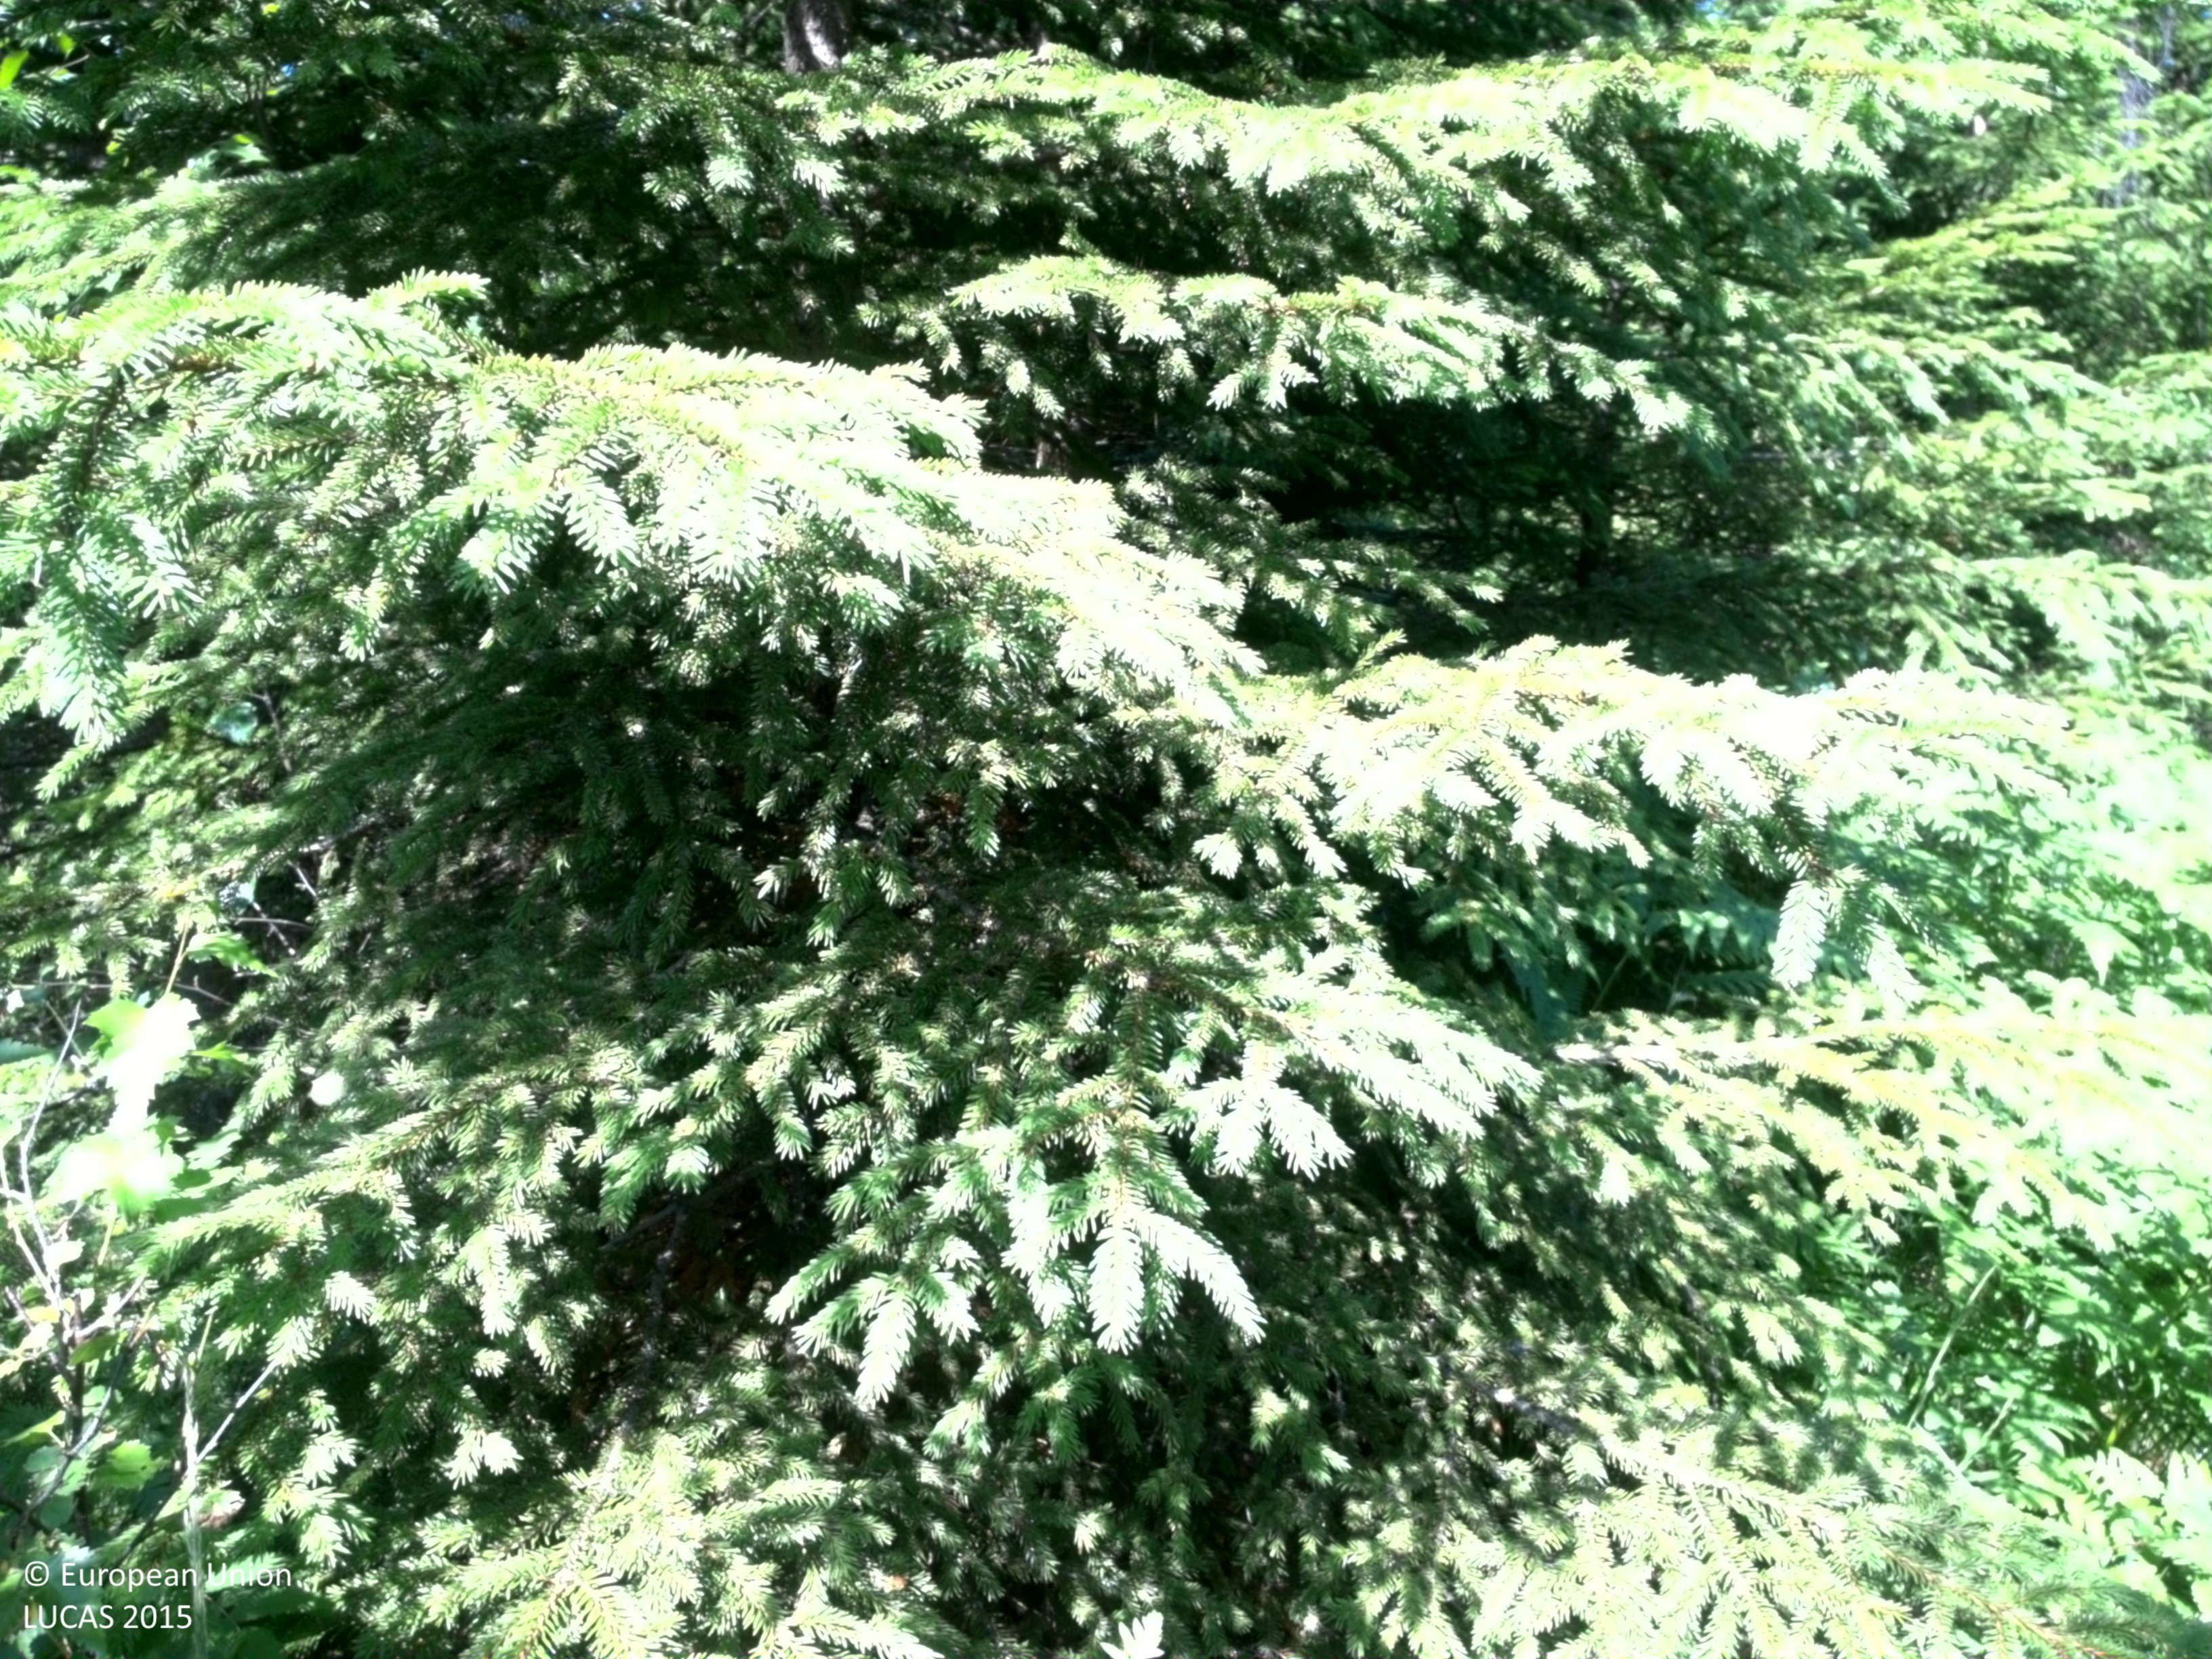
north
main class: Woodland
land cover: Spruce dominated mixed woodland
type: boreal forest
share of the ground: > 75 %
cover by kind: coniferous forest trees 50 %, broadleaved forest trees 30 %, herbaceous plants 15 %, shrubs 5 %
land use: Forestry
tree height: < 5 m
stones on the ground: < 10 %
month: July
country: SE
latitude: 59.1157
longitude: 14.5506
